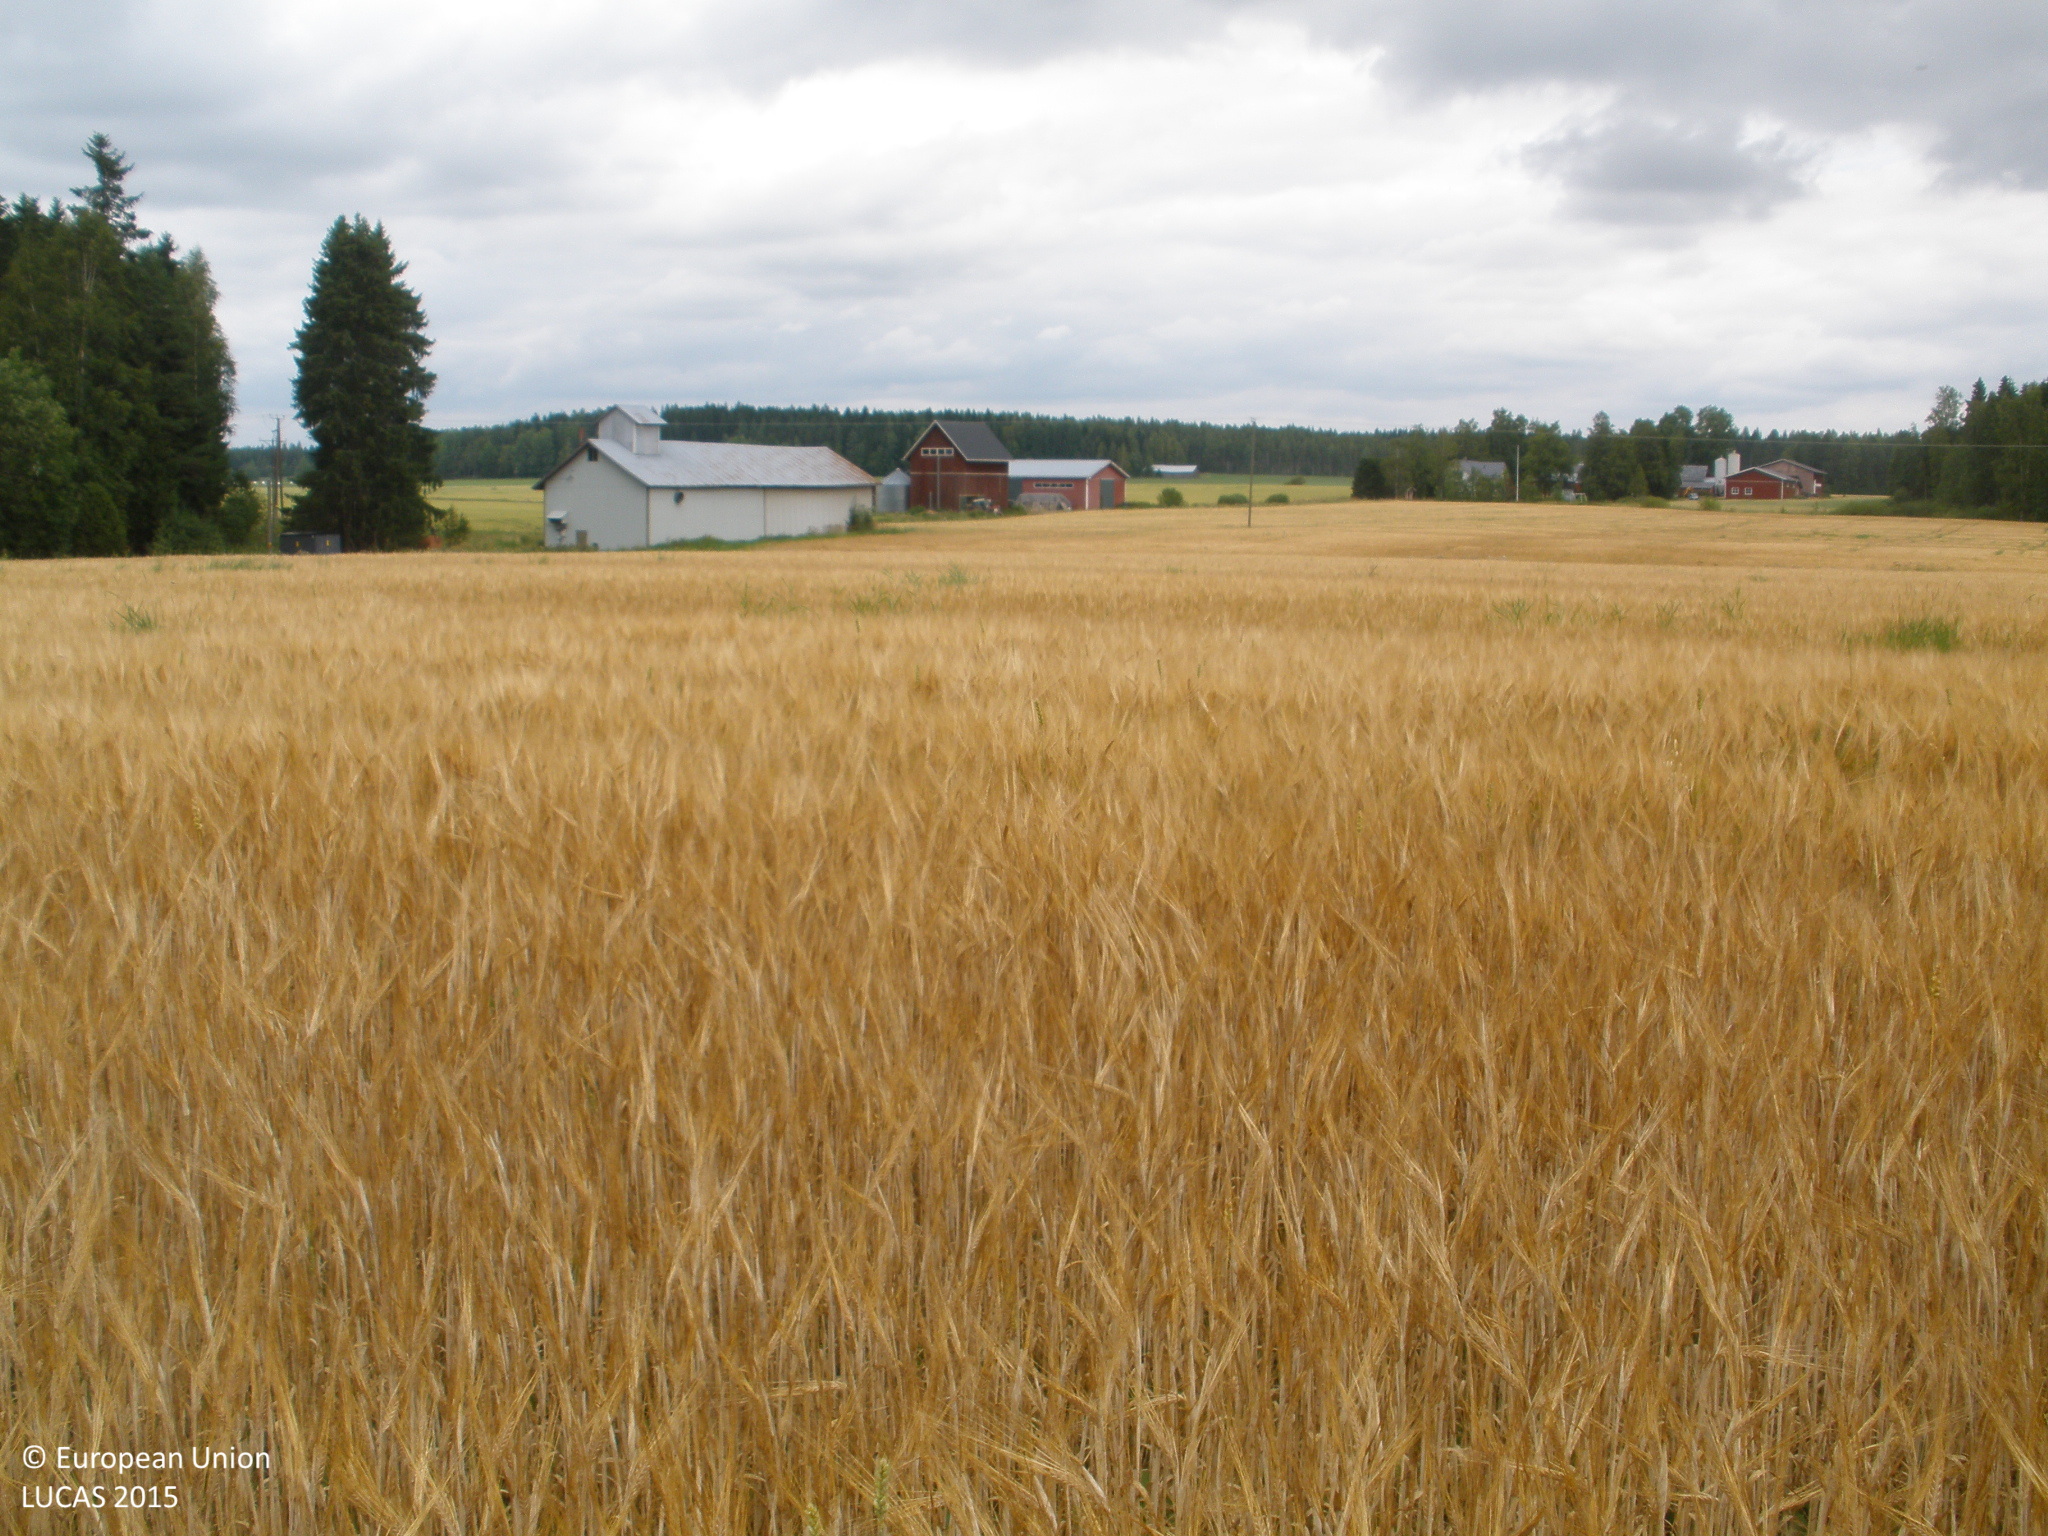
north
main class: Cropland
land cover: Barley
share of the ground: > 75 %
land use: Agriculture (excluding fallow land and kitchen gardens)
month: August
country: FI
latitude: 60.5822
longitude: 23.5755
